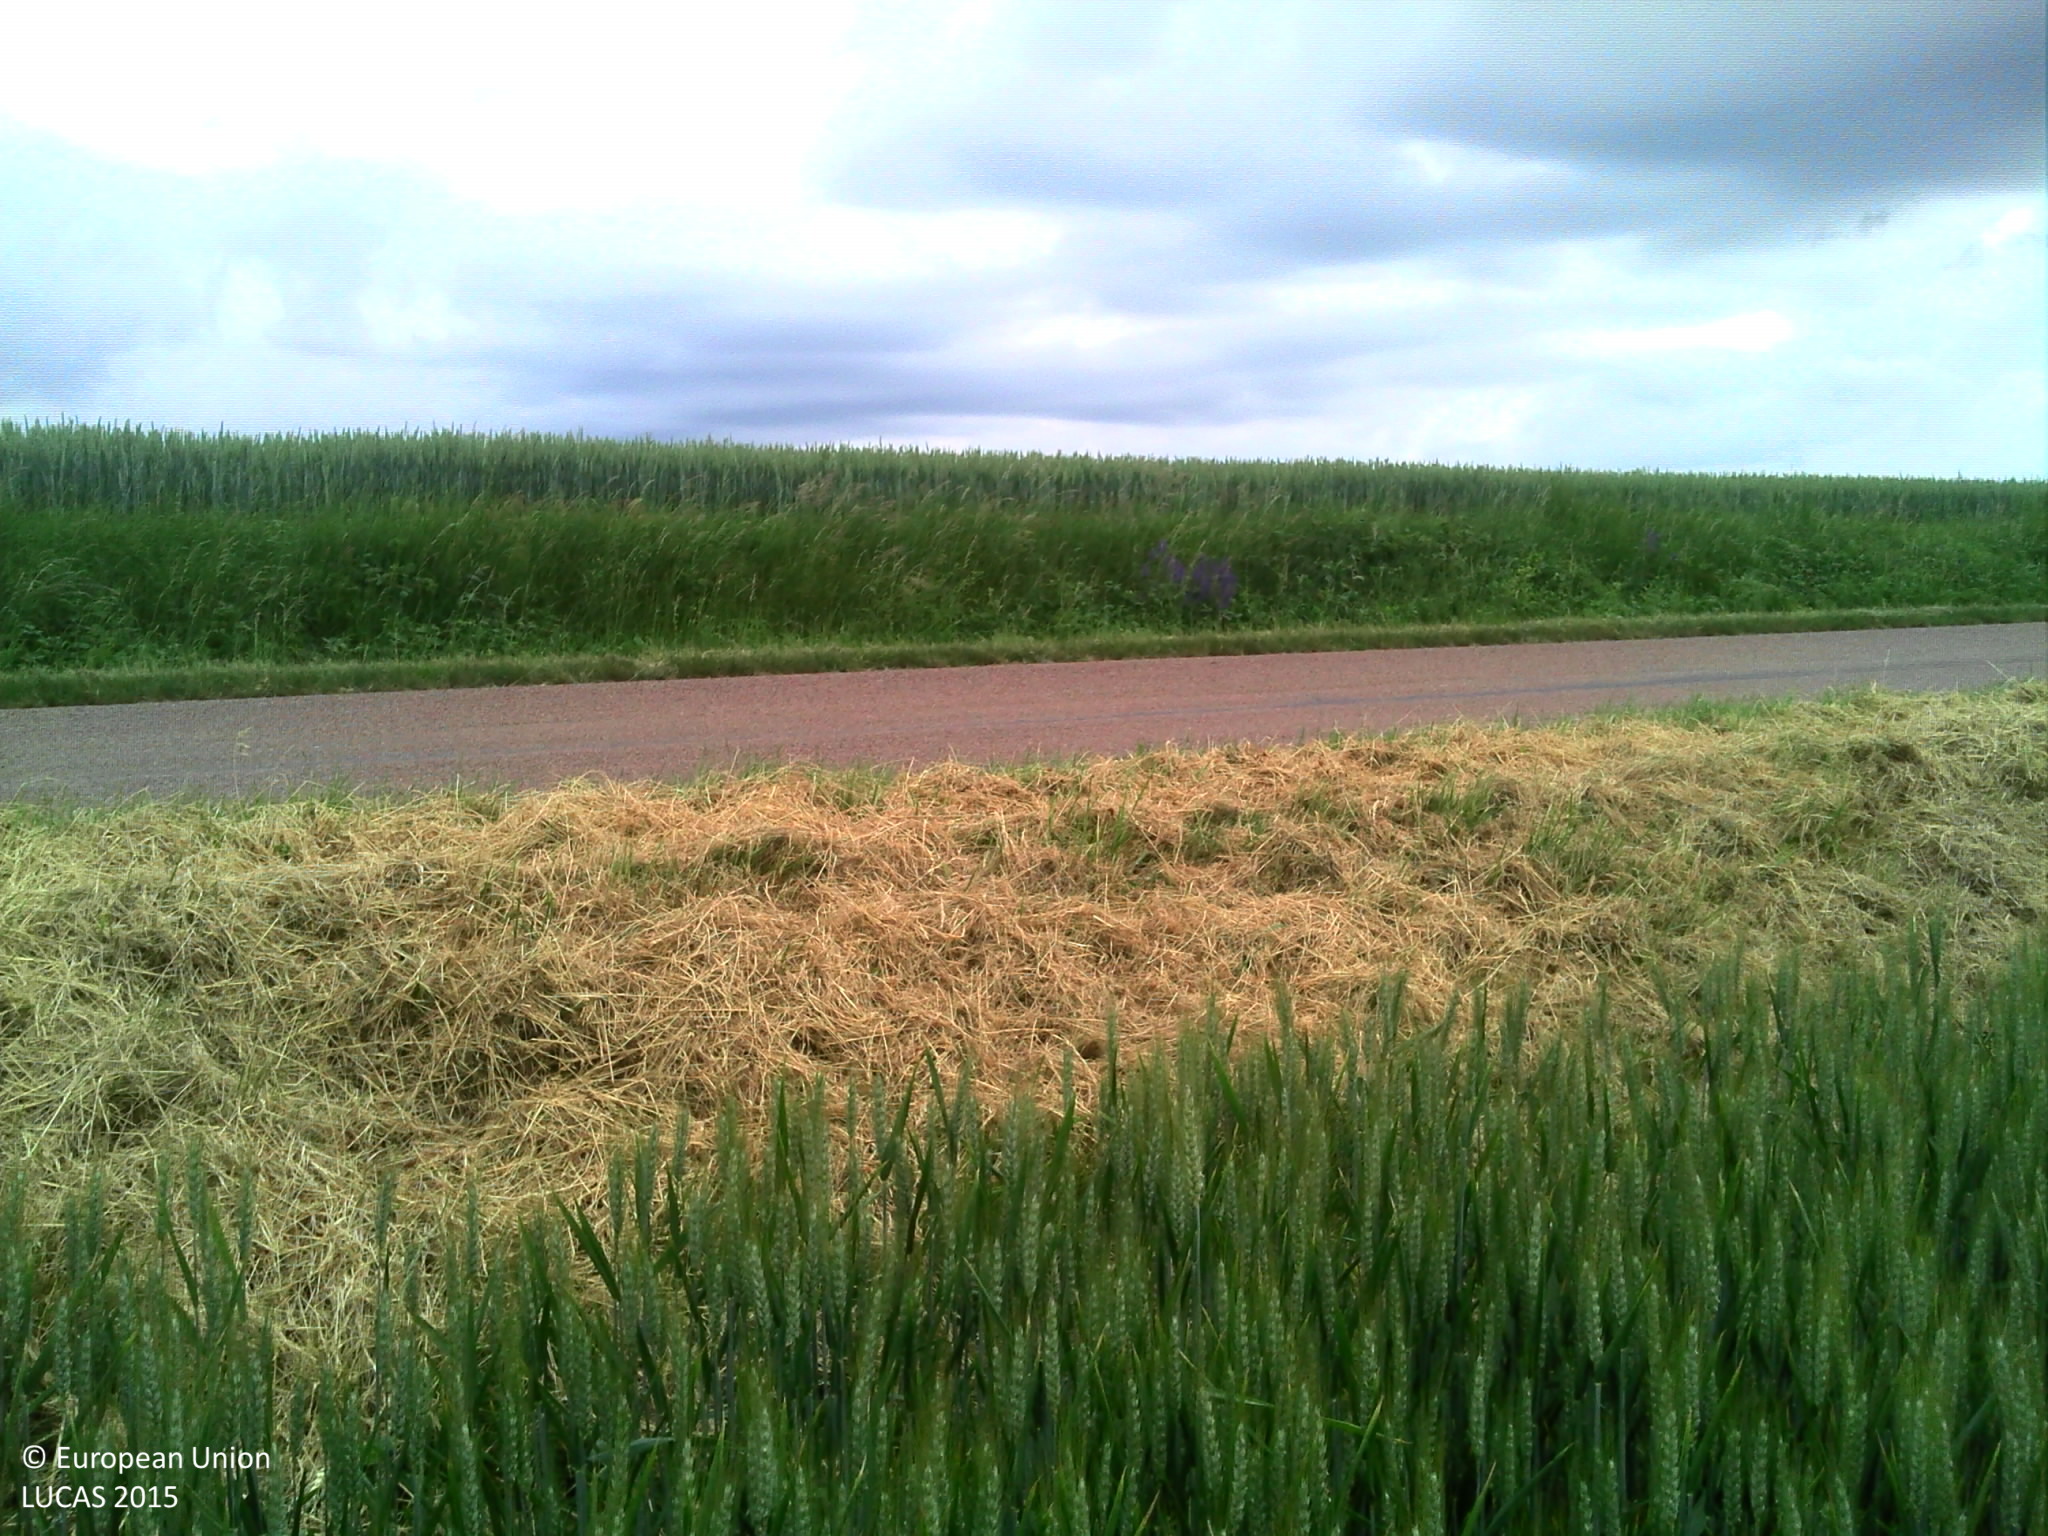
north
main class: Cropland
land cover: Common wheat
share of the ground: > 75 %
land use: Agriculture (excluding fallow land and kitchen gardens)
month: May
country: FR
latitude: 47.7852
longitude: 3.9238
